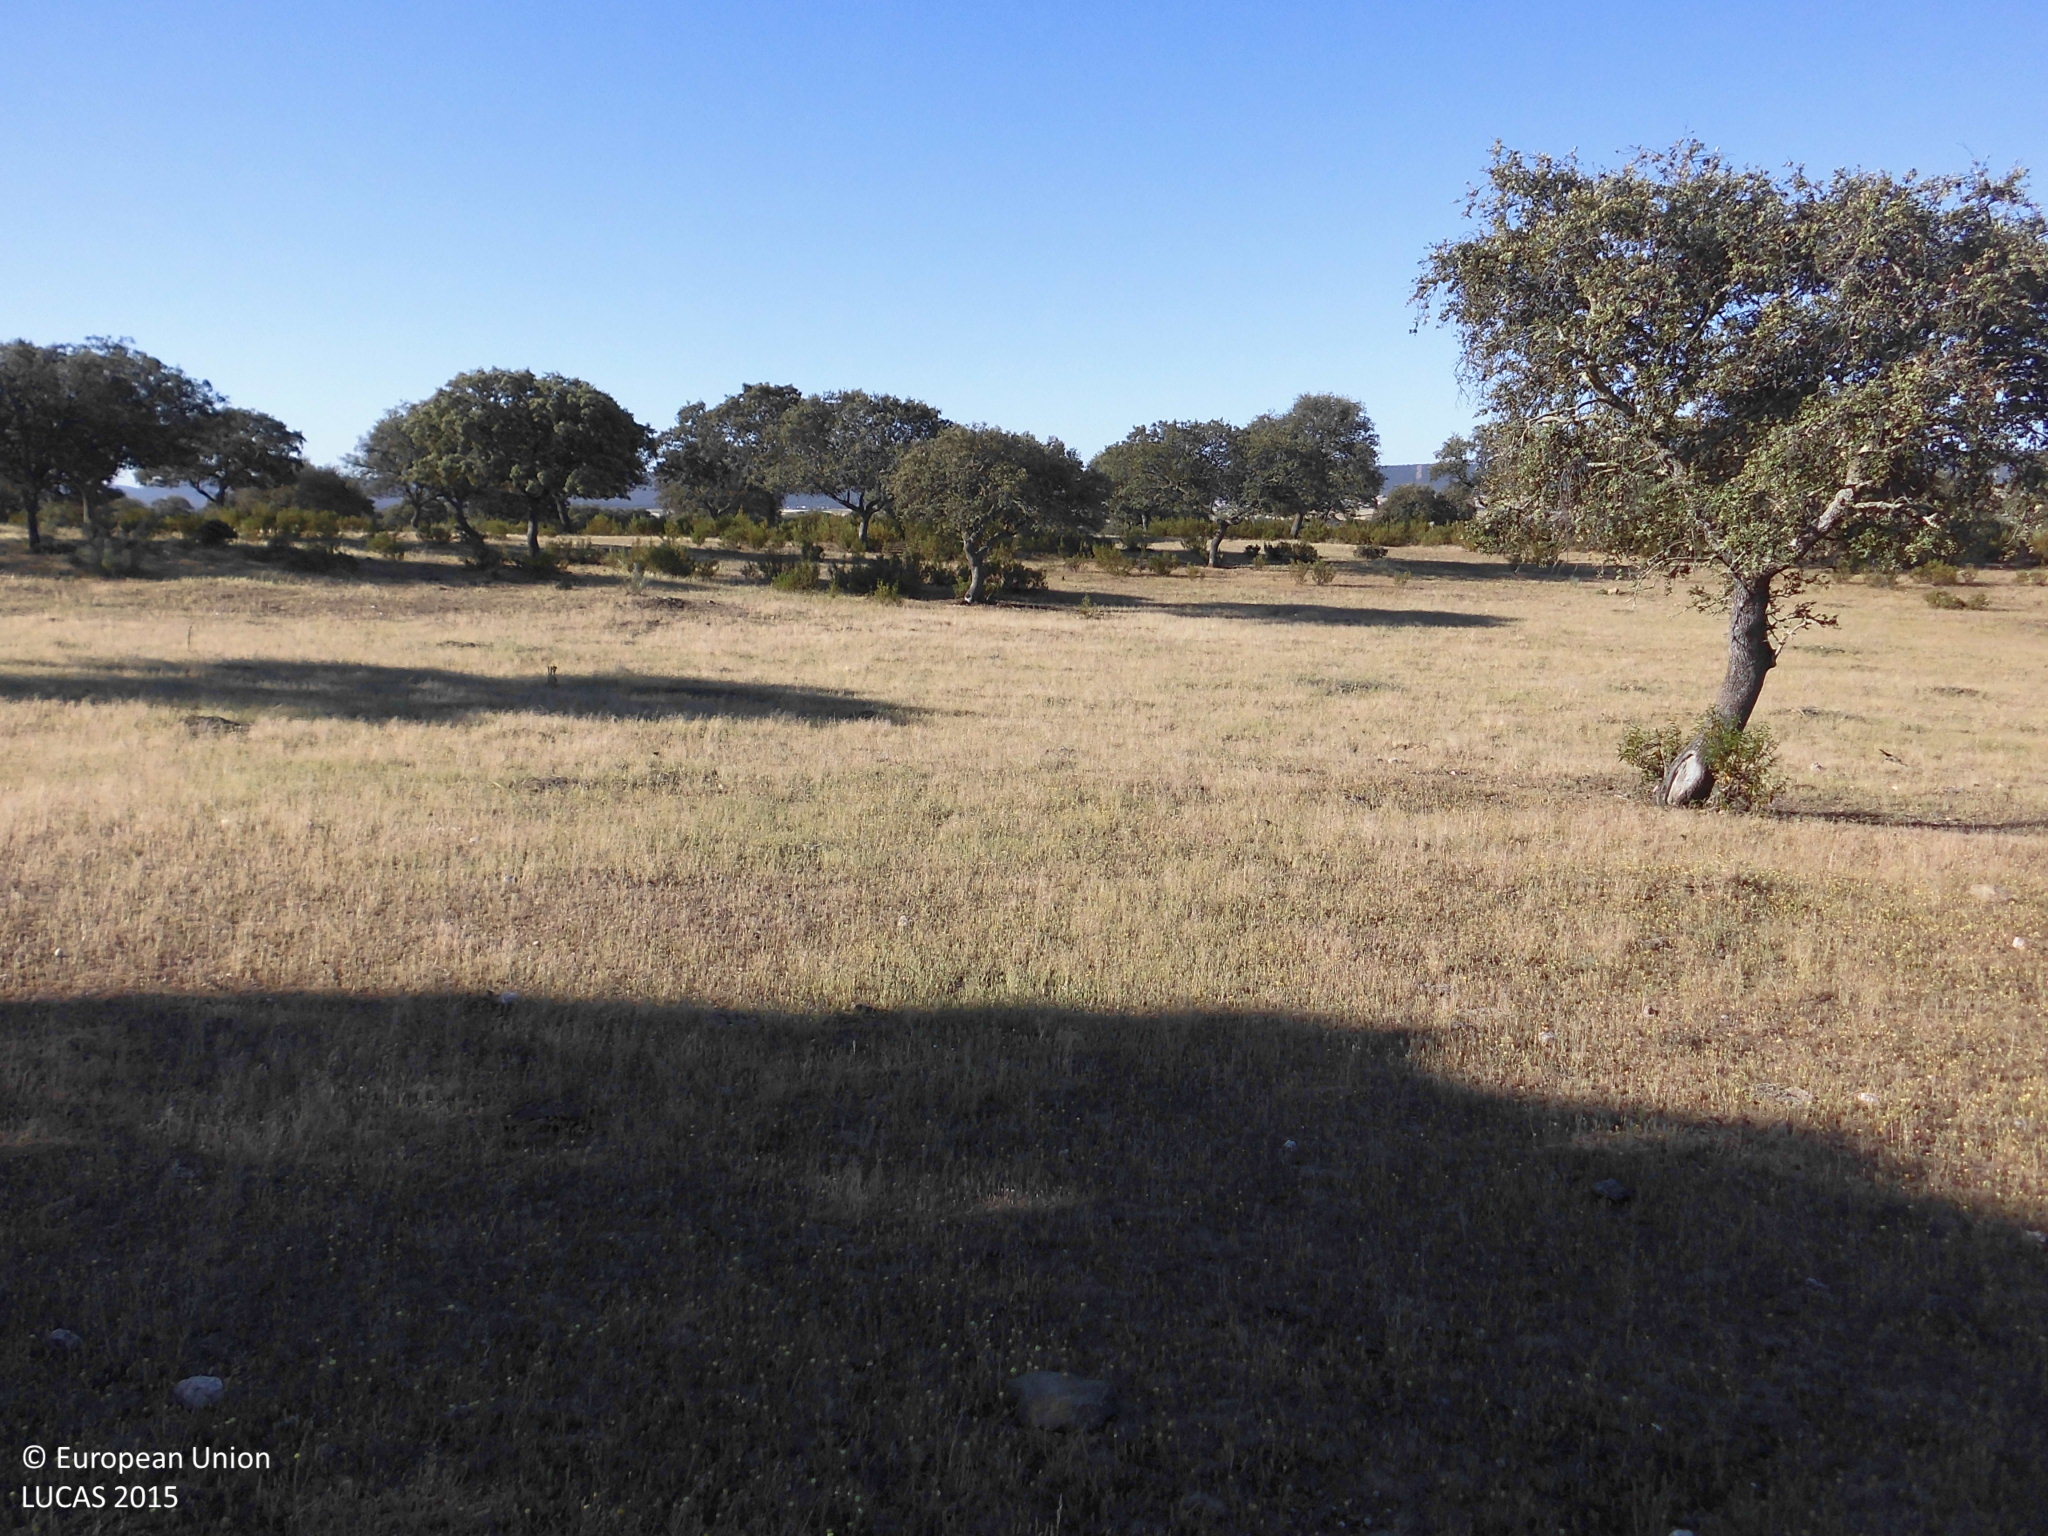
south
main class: Woodland
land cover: Broadleaved woodland
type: broadleaved evergreen forest
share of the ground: 10 - 25 %
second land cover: Grassland without tree/shrub cover
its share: > 75 %
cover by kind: herbaceous plants 50 %, broadleaved forest trees 25 %, shrubs 25 %
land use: Forestry
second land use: Agriculture (excluding fallow land and kitchen gardens)
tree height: > 5 m
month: May
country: ES
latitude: 39.5083
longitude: -7.0041
